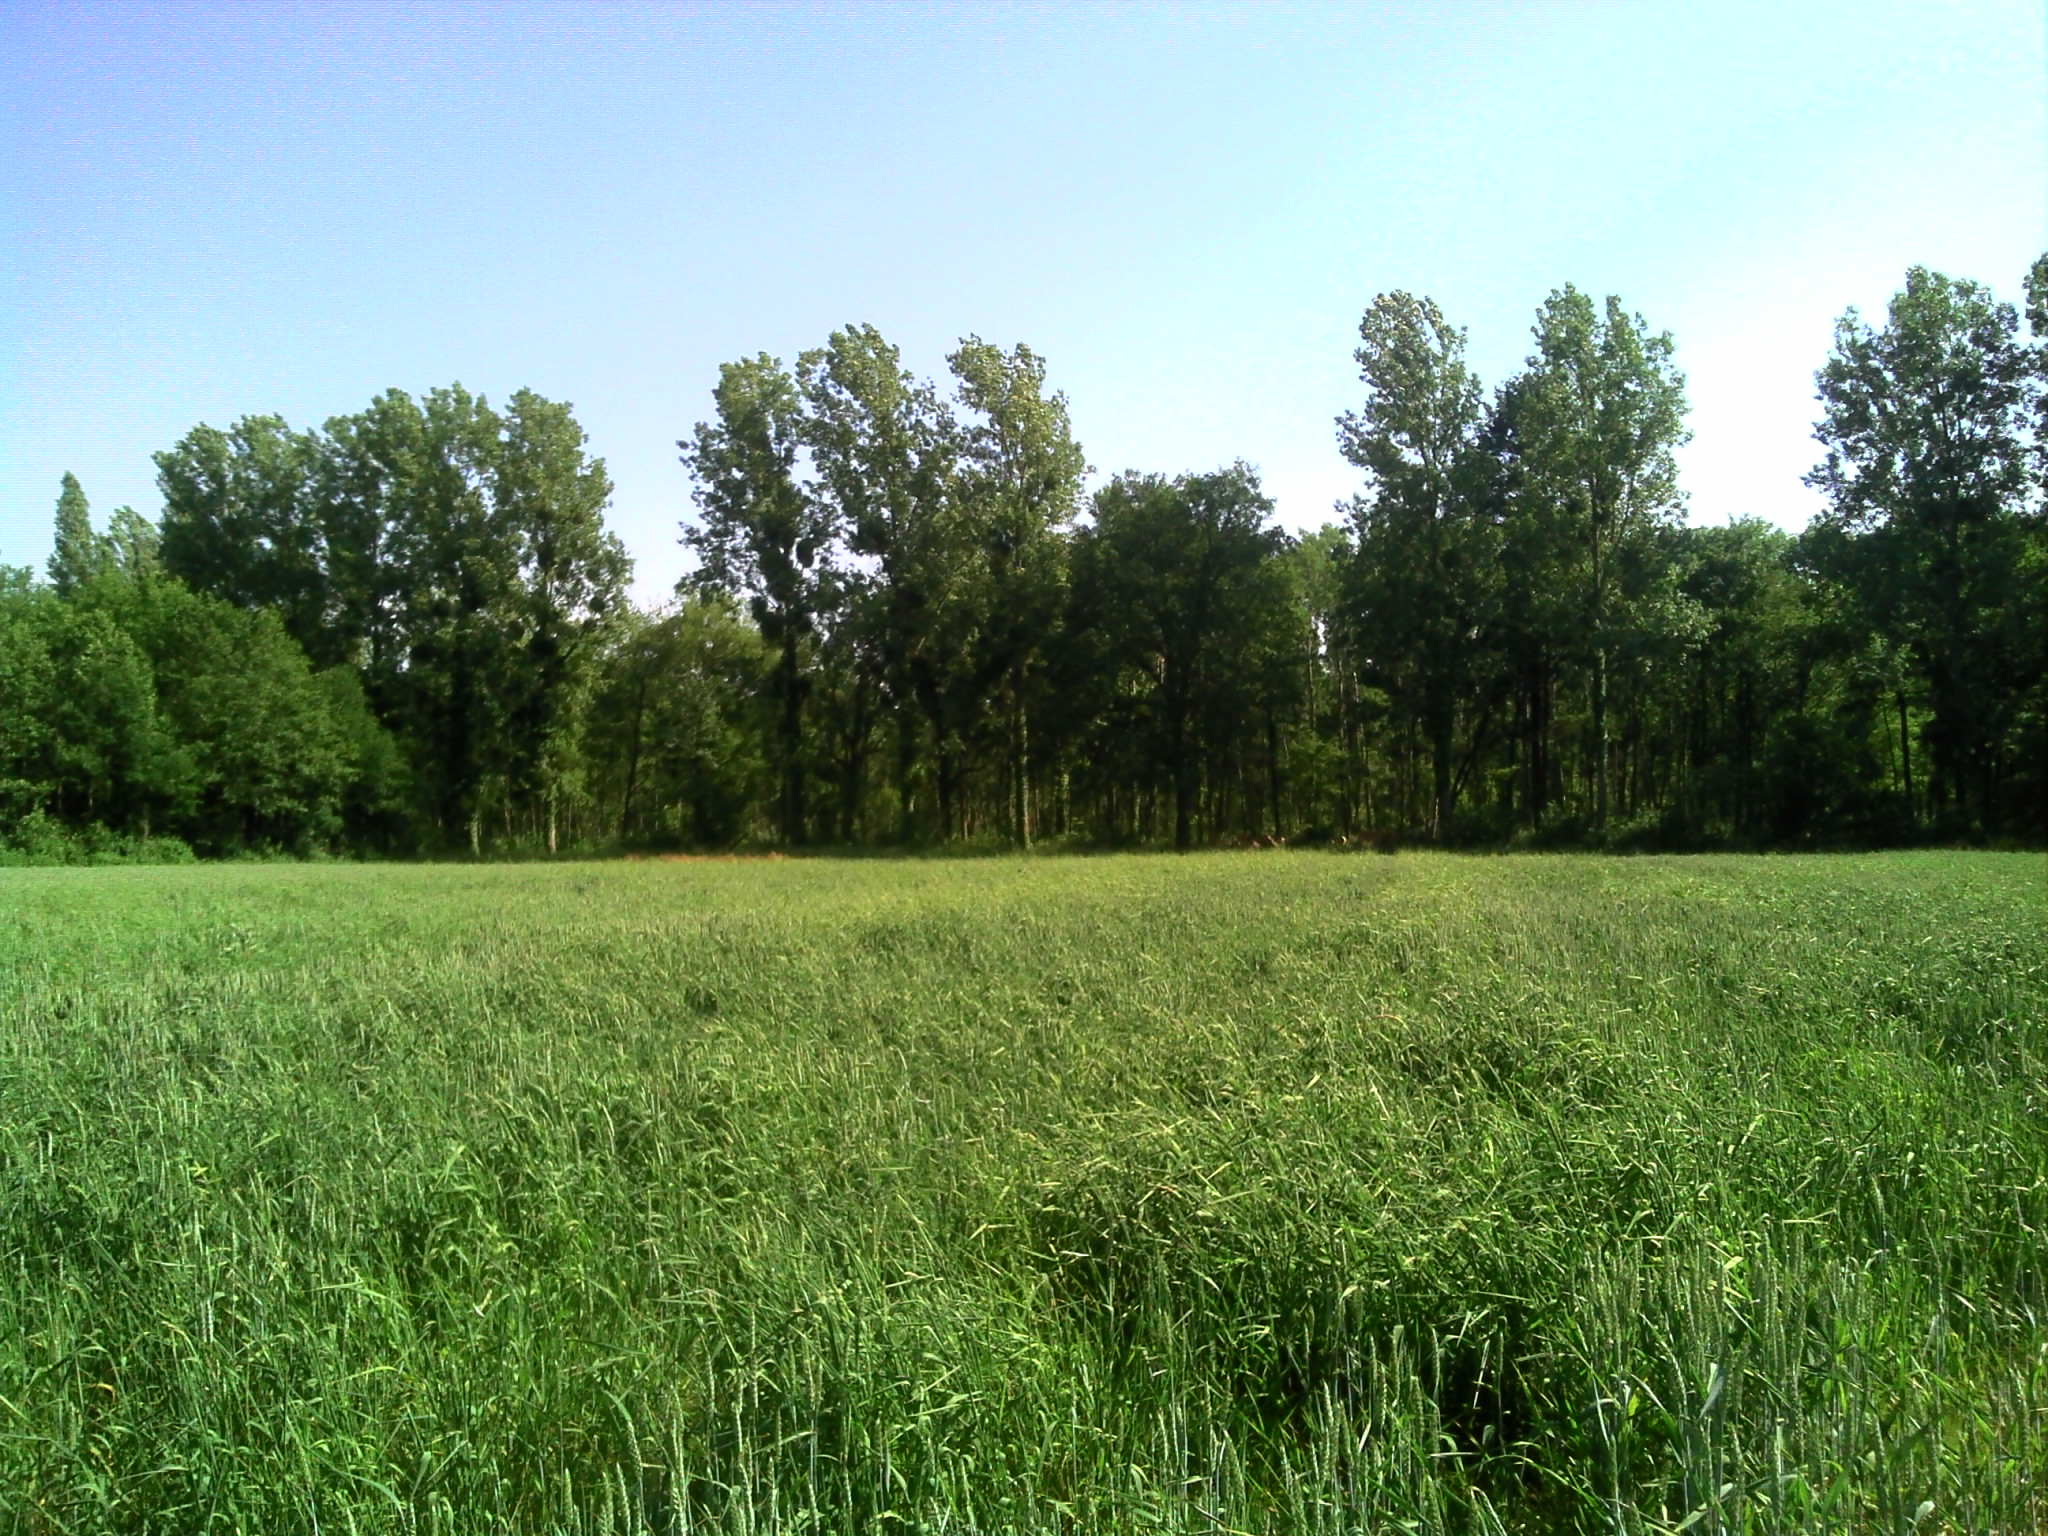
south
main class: Cropland
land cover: Common wheat
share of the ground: > 75 %
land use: Agriculture (excluding fallow land and kitchen gardens)
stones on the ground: < 10 %
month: May
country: FR
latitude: 46.5390
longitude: 4.9556
